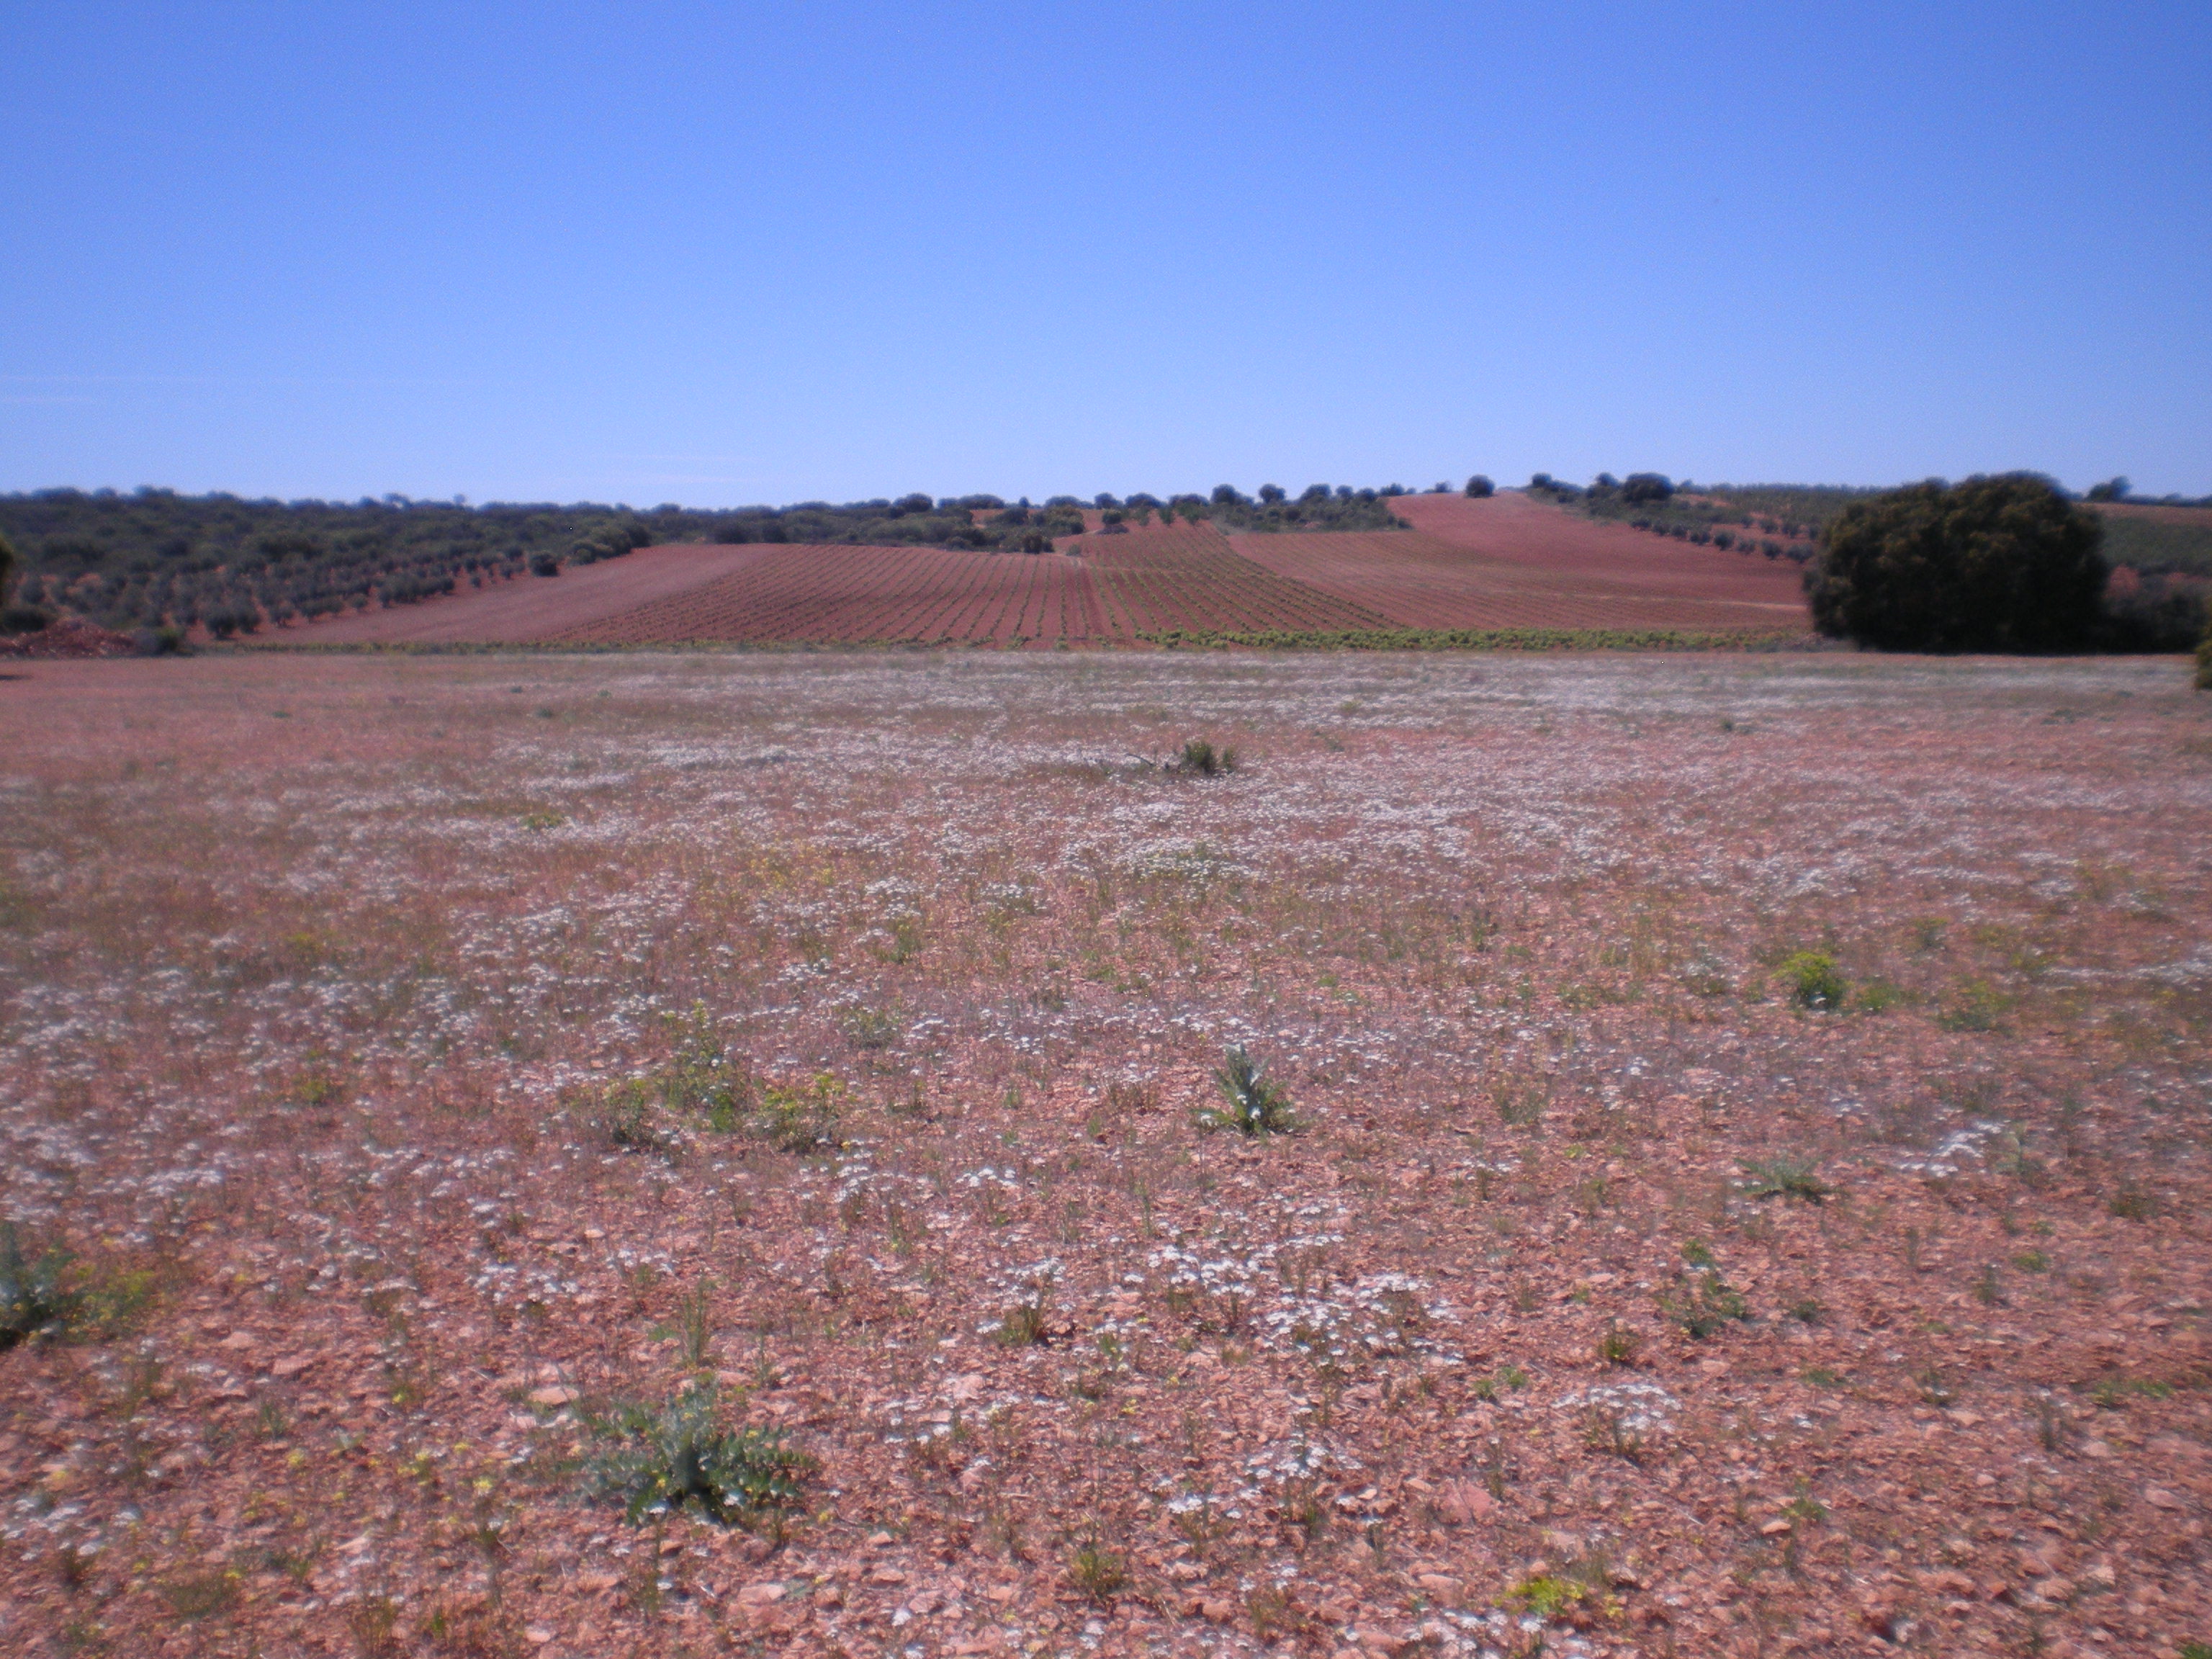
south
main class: Grassland
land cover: Spontaneously vegetated surfaces
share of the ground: > 75 %
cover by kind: unconsolidated bare surface 70 %, herbaceous plants 30 %
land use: Fallow land
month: May
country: ES
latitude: 38.9957
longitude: -2.9995
